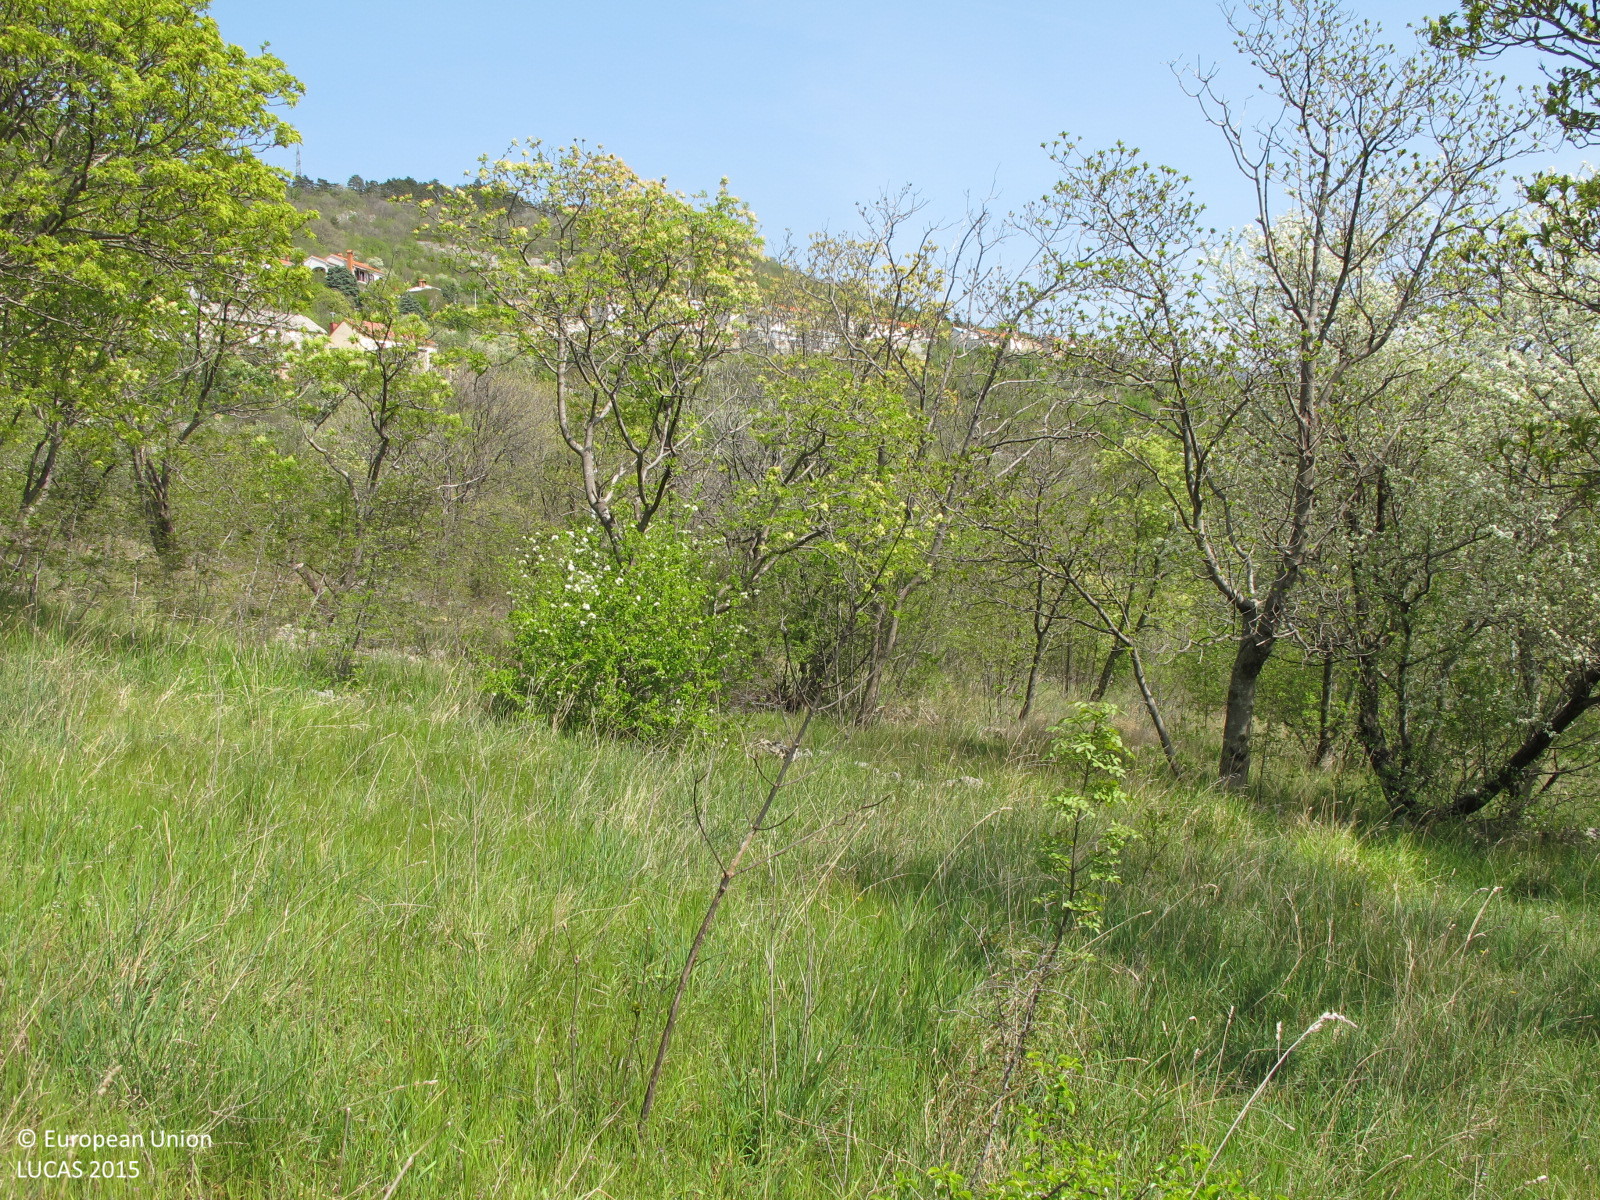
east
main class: Grassland
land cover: Grassland with sparse tree/shrub cover
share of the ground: > 75 %
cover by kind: herbaceous plants 70 %, shrubs 10 %, broadleaved forest trees 5 %
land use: Abandoned areas
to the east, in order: Grassland with sparse tree/shrub cover; Tracks; Grassland with sparse tree/shrub cover; Paved roads, cycling and walking lanes; Broadleaved woodland; Grassland with sparse tree/shrub cover; Dry stone walls; Grassland with sparse tree/shrub cover; Broadleaved woodland
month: April
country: HR
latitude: 45.2971
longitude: 14.5729
